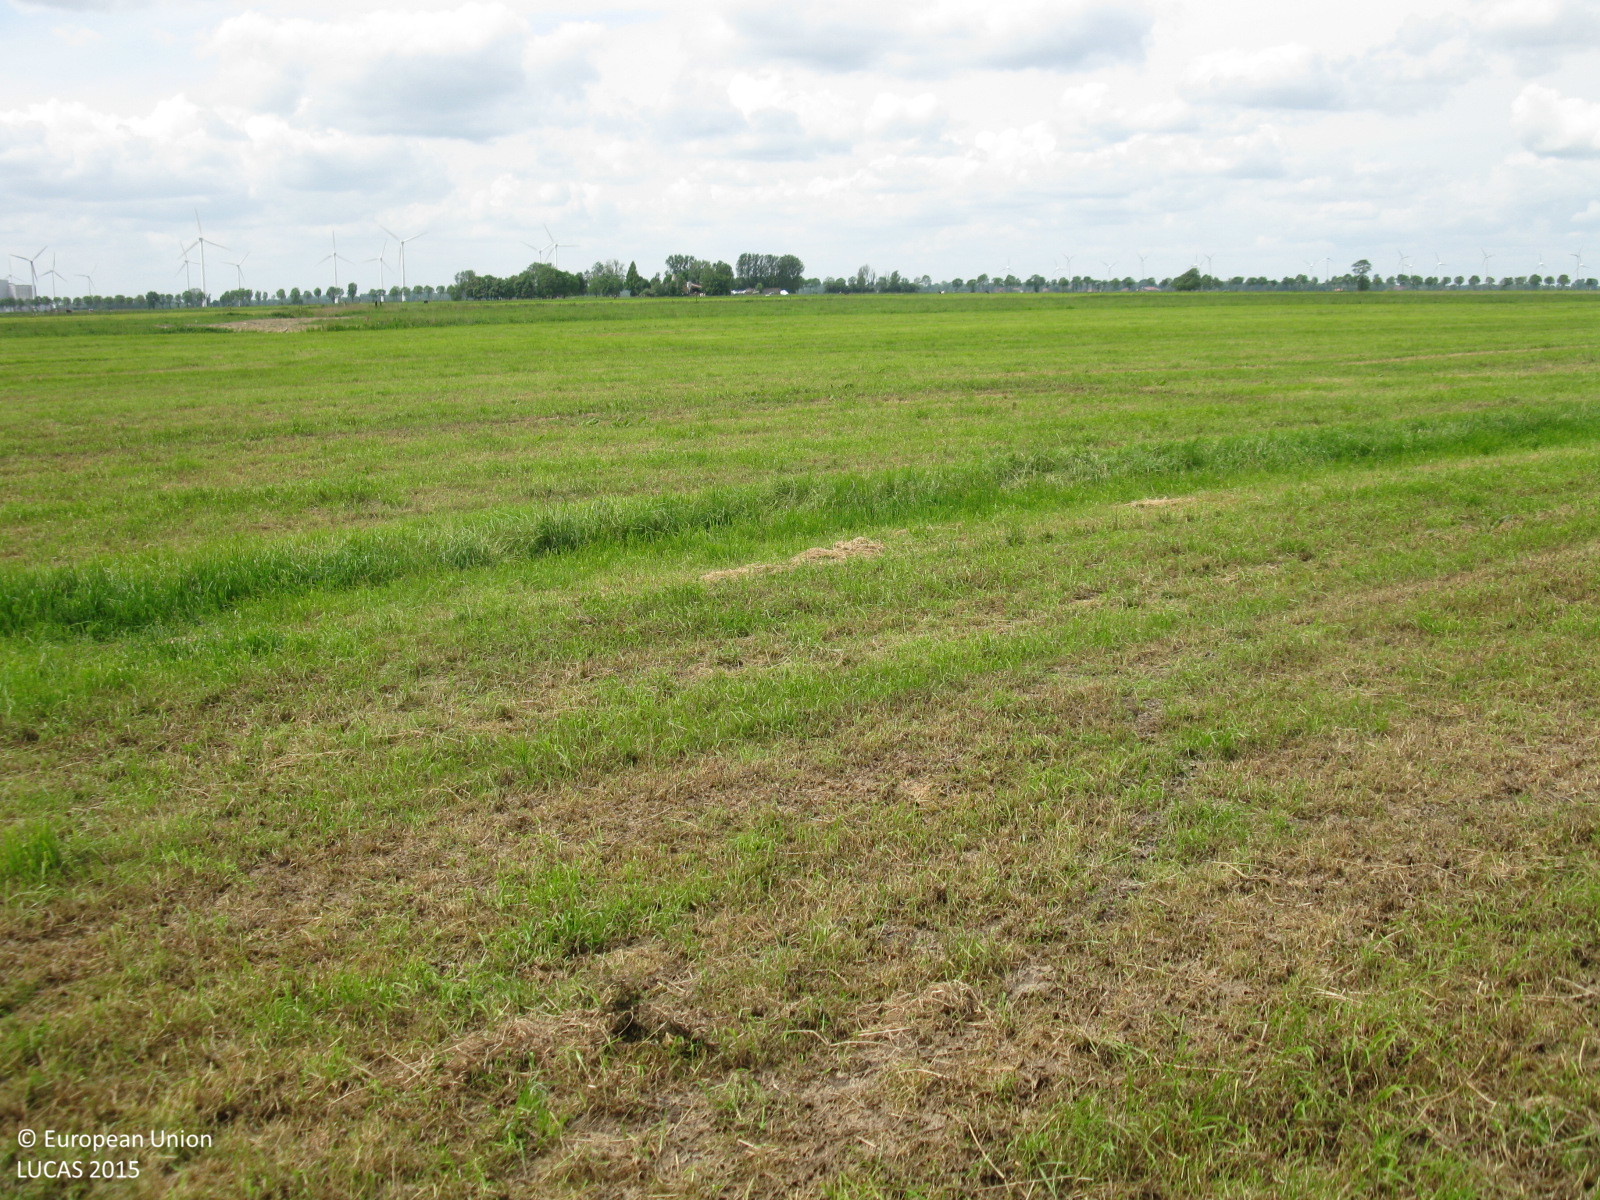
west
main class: Grassland
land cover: Grassland without tree/shrub cover
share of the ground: > 75 %
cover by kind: herbaceous plants 100 %
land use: Agriculture (excluding fallow land and kitchen gardens)
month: June
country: DE
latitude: 53.1938
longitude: 7.3812
